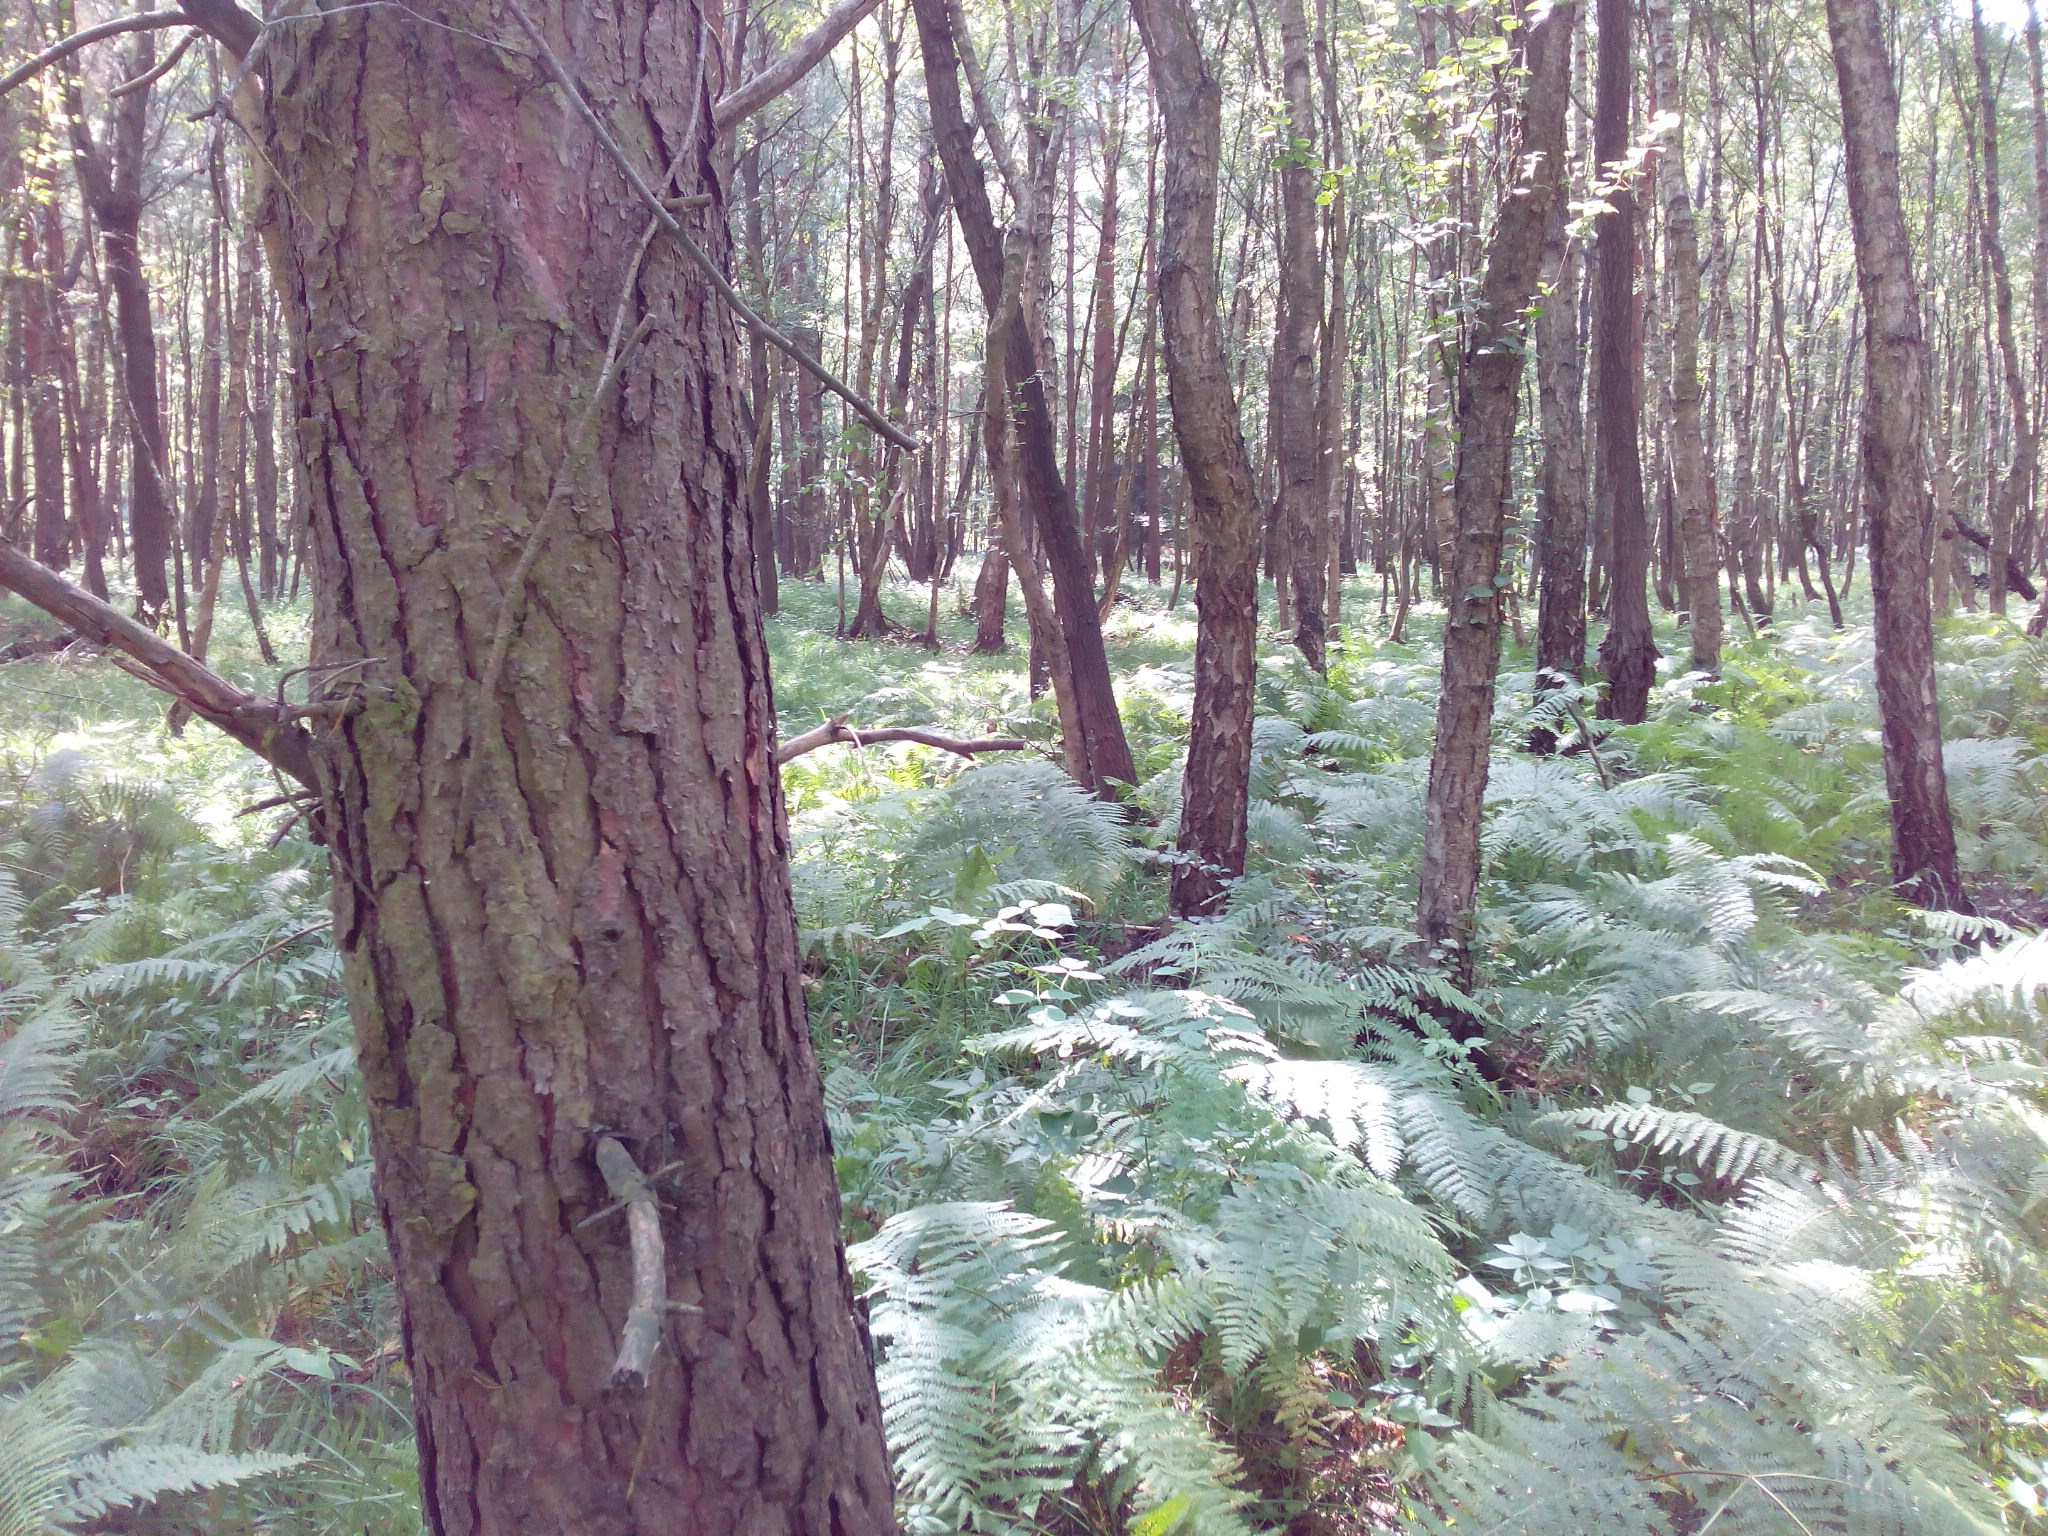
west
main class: Woodland
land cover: Pine dominated mixed woodland
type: hemiboreal forest and nemoral coniferous forest and mixed broadleaved-coniferous forest
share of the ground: > 75 %
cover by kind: broadleaved forest trees 50 %, coniferous forest trees 45 %, herbaceous plants 5 %
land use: Forestry
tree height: > 5 m
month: August
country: DE
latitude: 52.4134
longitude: 9.9265
